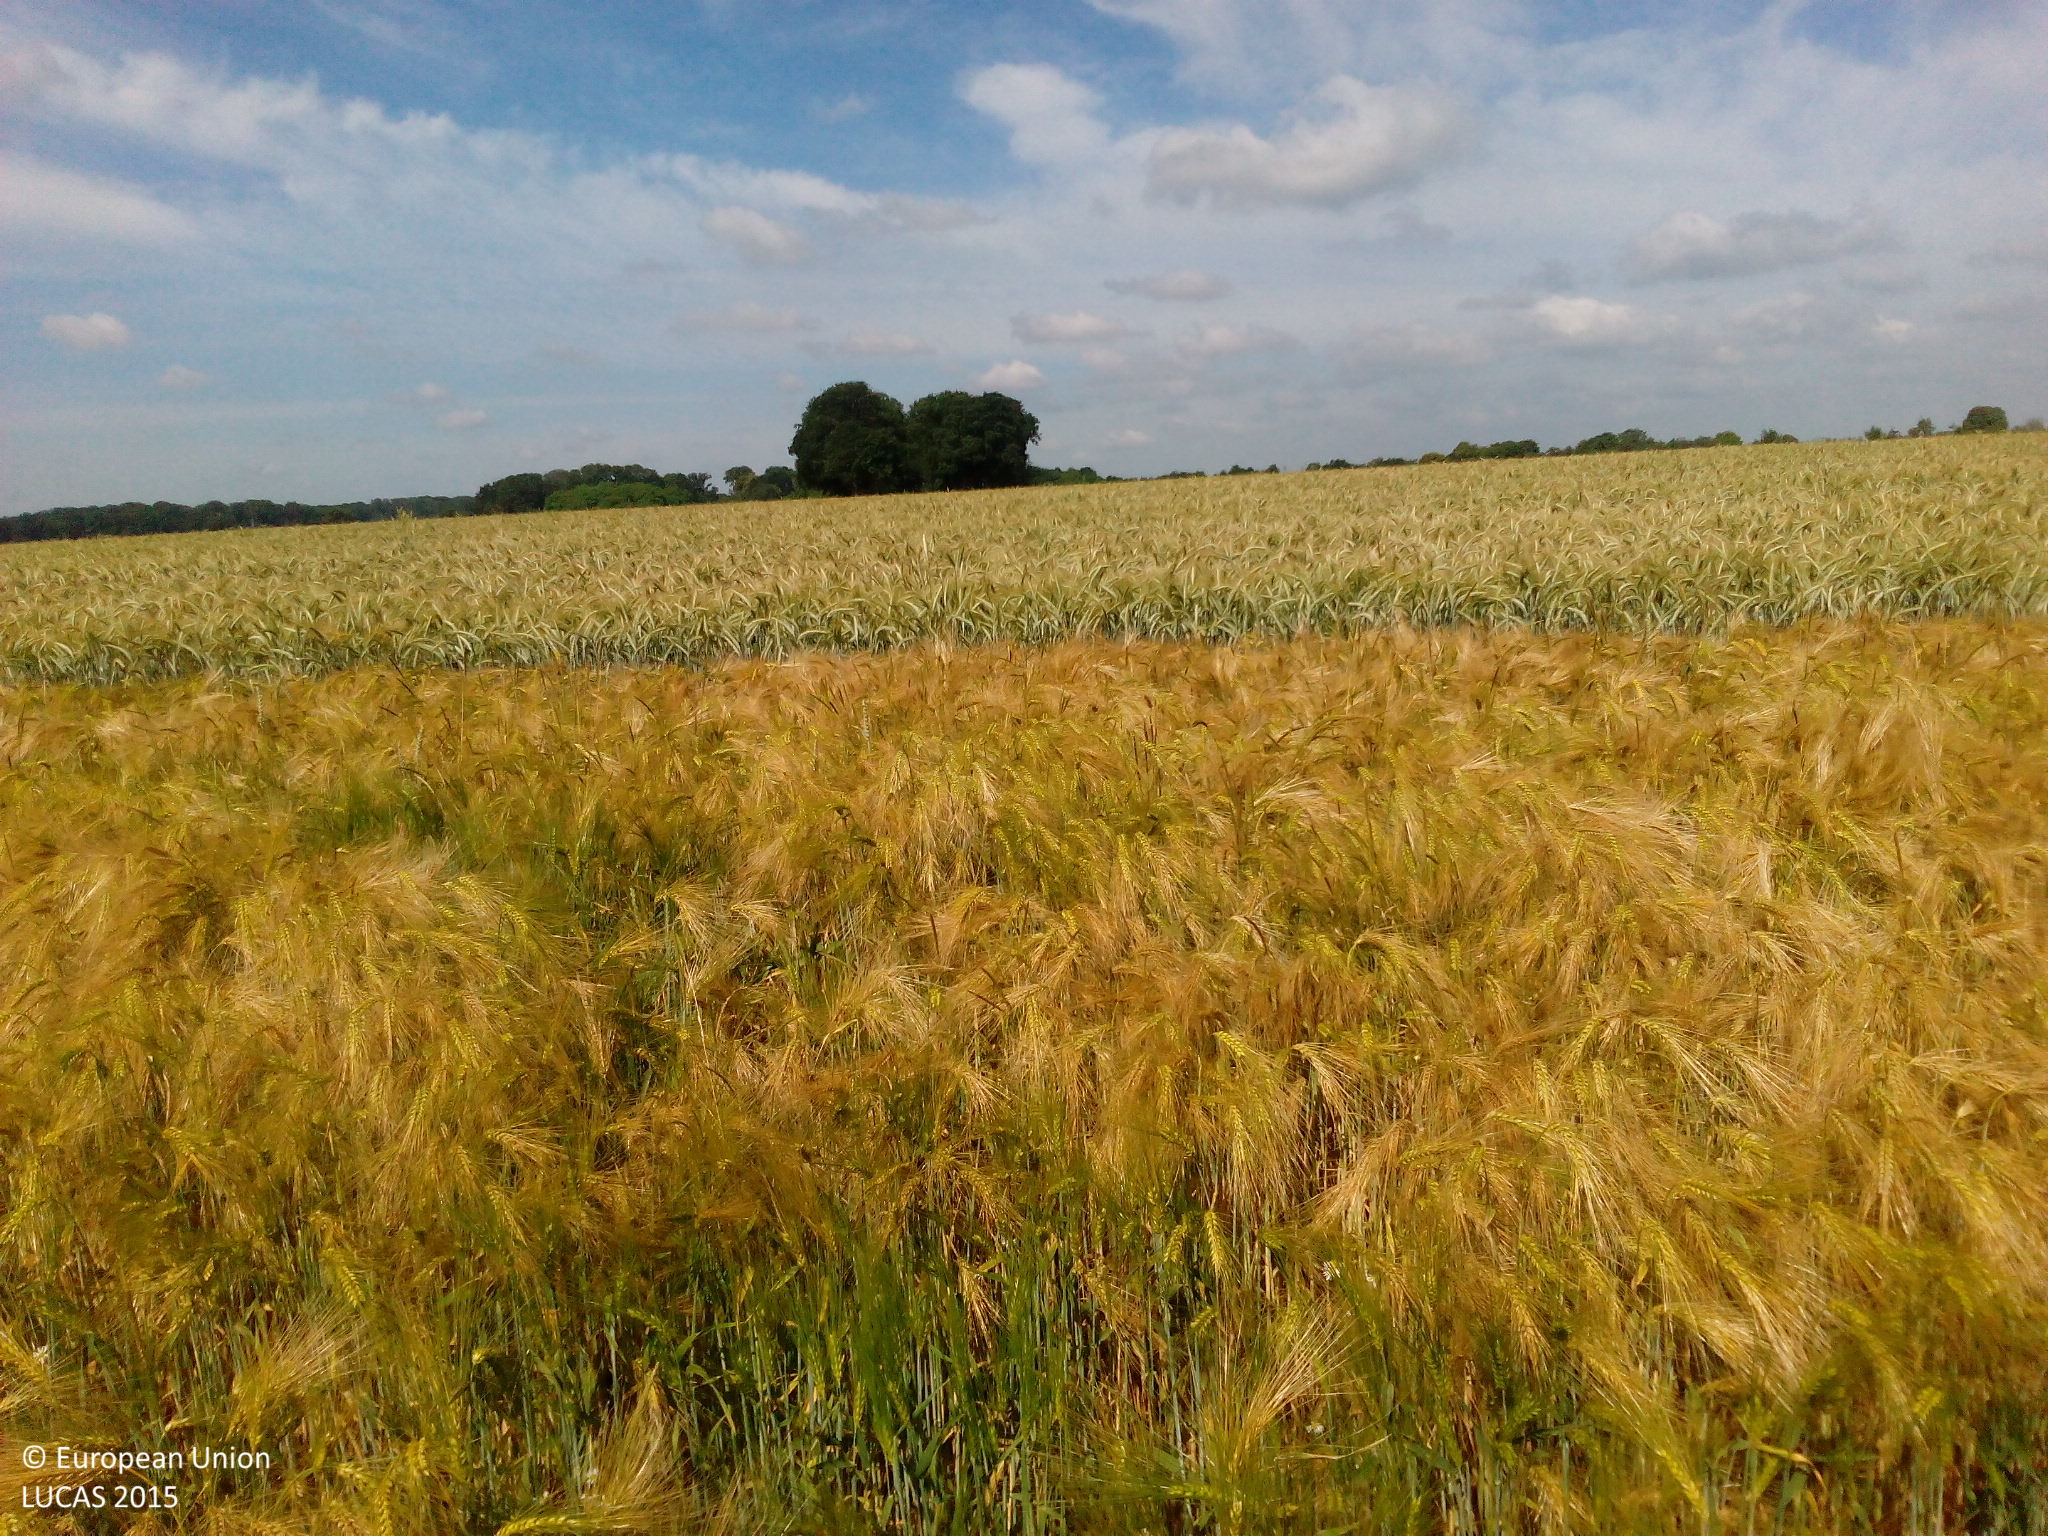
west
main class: Cropland
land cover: Barley
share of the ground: > 75 %
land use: Agriculture (excluding fallow land and kitchen gardens)
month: June
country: DE
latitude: 51.6677
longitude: 8.5690
